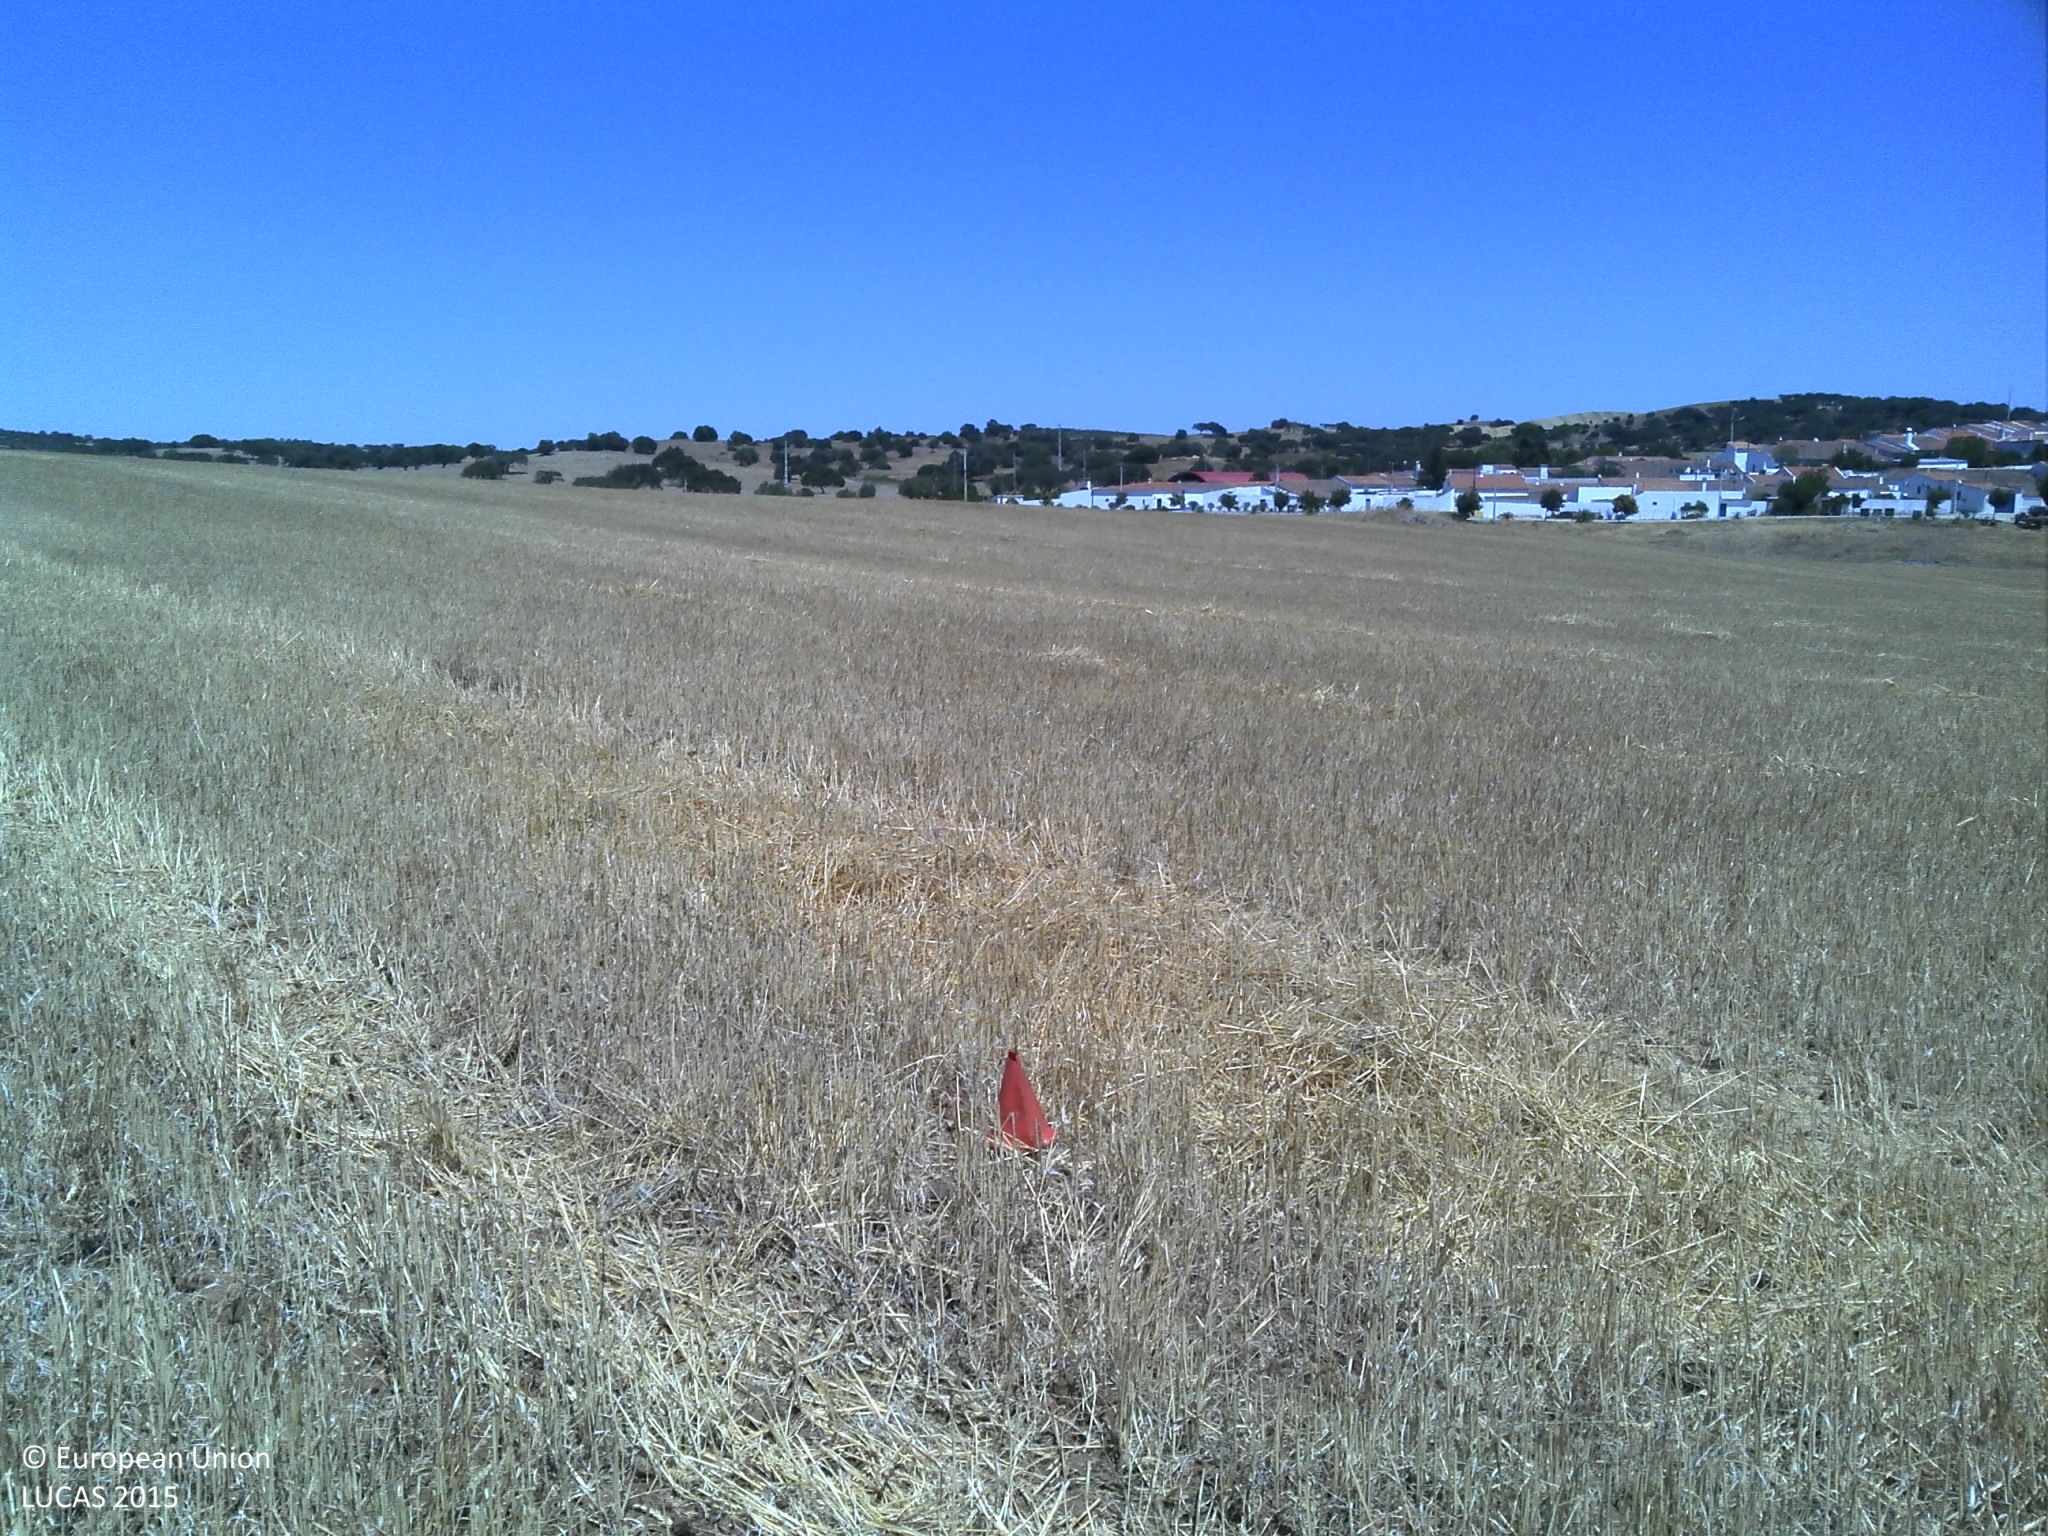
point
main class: Cropland
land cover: Common wheat
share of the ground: 50 - 75 %
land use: Agriculture (excluding fallow land and kitchen gardens)
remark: Harvested field
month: July
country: PT
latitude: 38.0241
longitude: -8.0424
